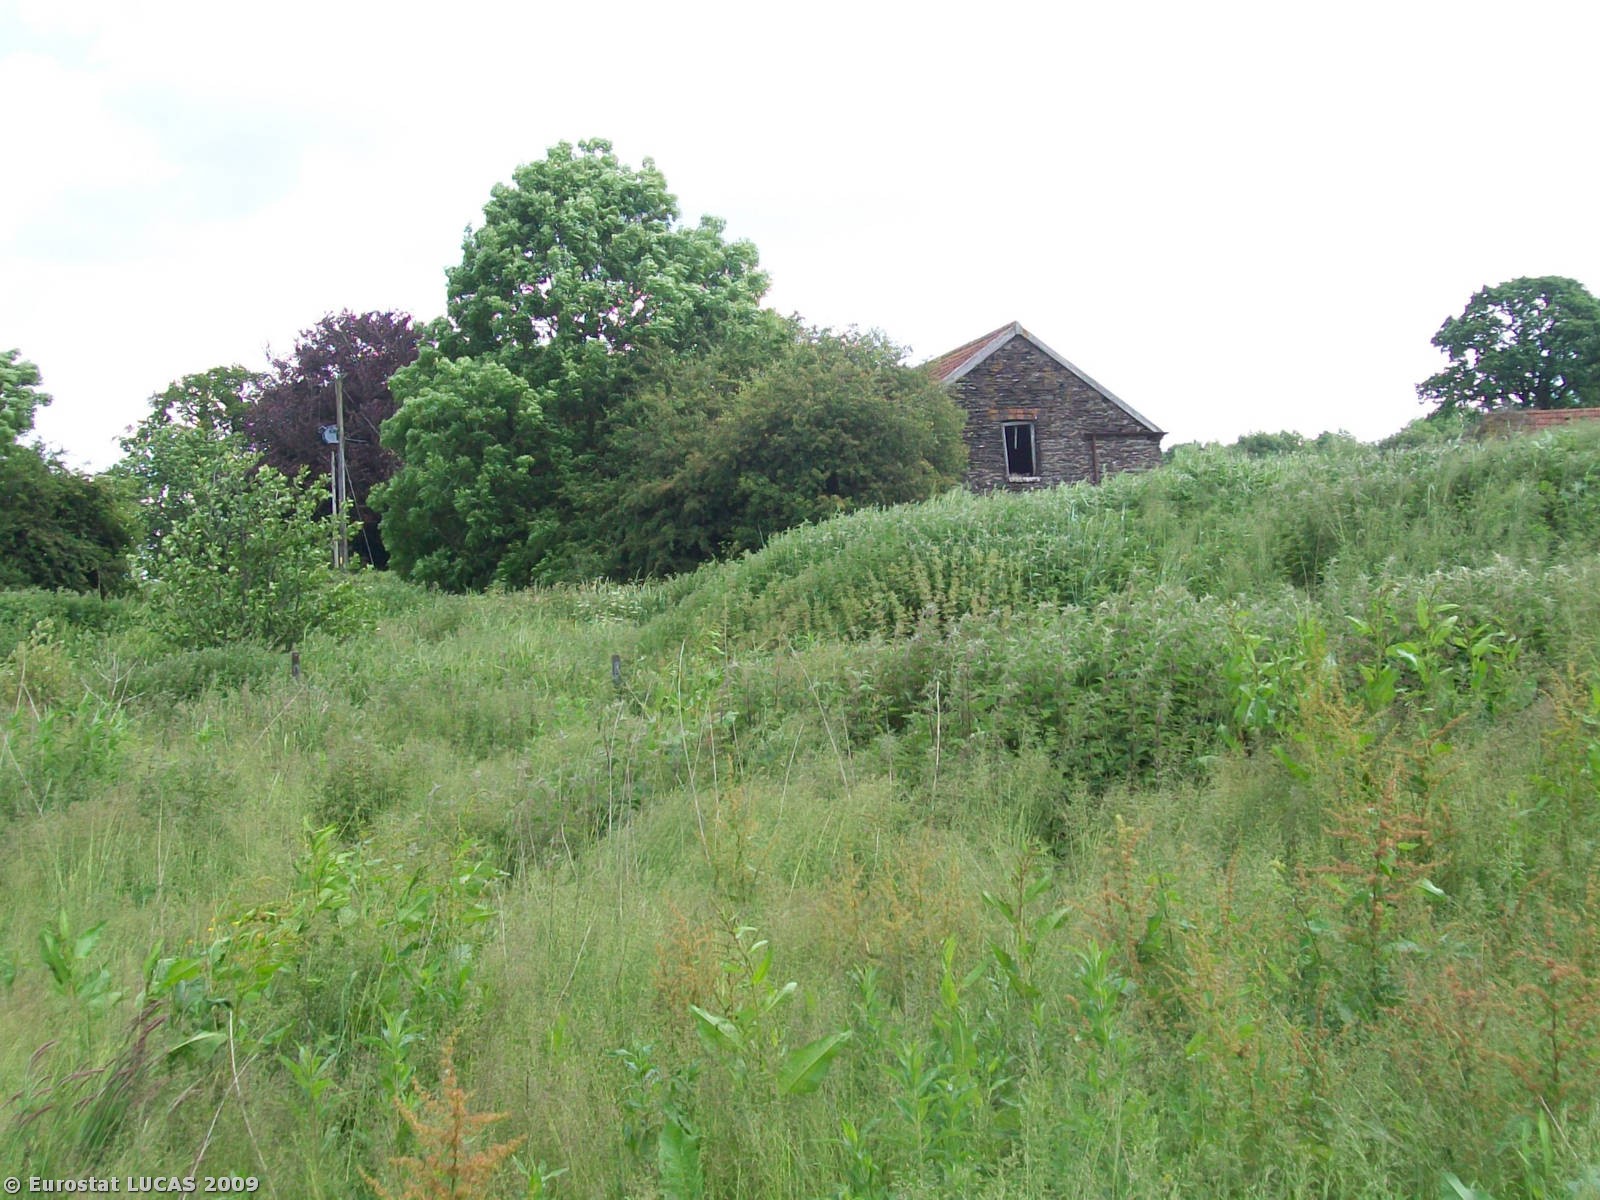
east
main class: Grassland
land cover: Grassland without tree/shrub cover
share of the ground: > 75 %
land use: Agriculture (excluding fallow land and kitchen gardens)
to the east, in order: Grassland without tree/shrub cover; Inland water bodies; Grassland without tree/shrub cover; Artificial constructions in urban areas; Broadleaved woodland; Arable land (only in case pi)
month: June
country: GB
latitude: 51.0104
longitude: -3.4089
